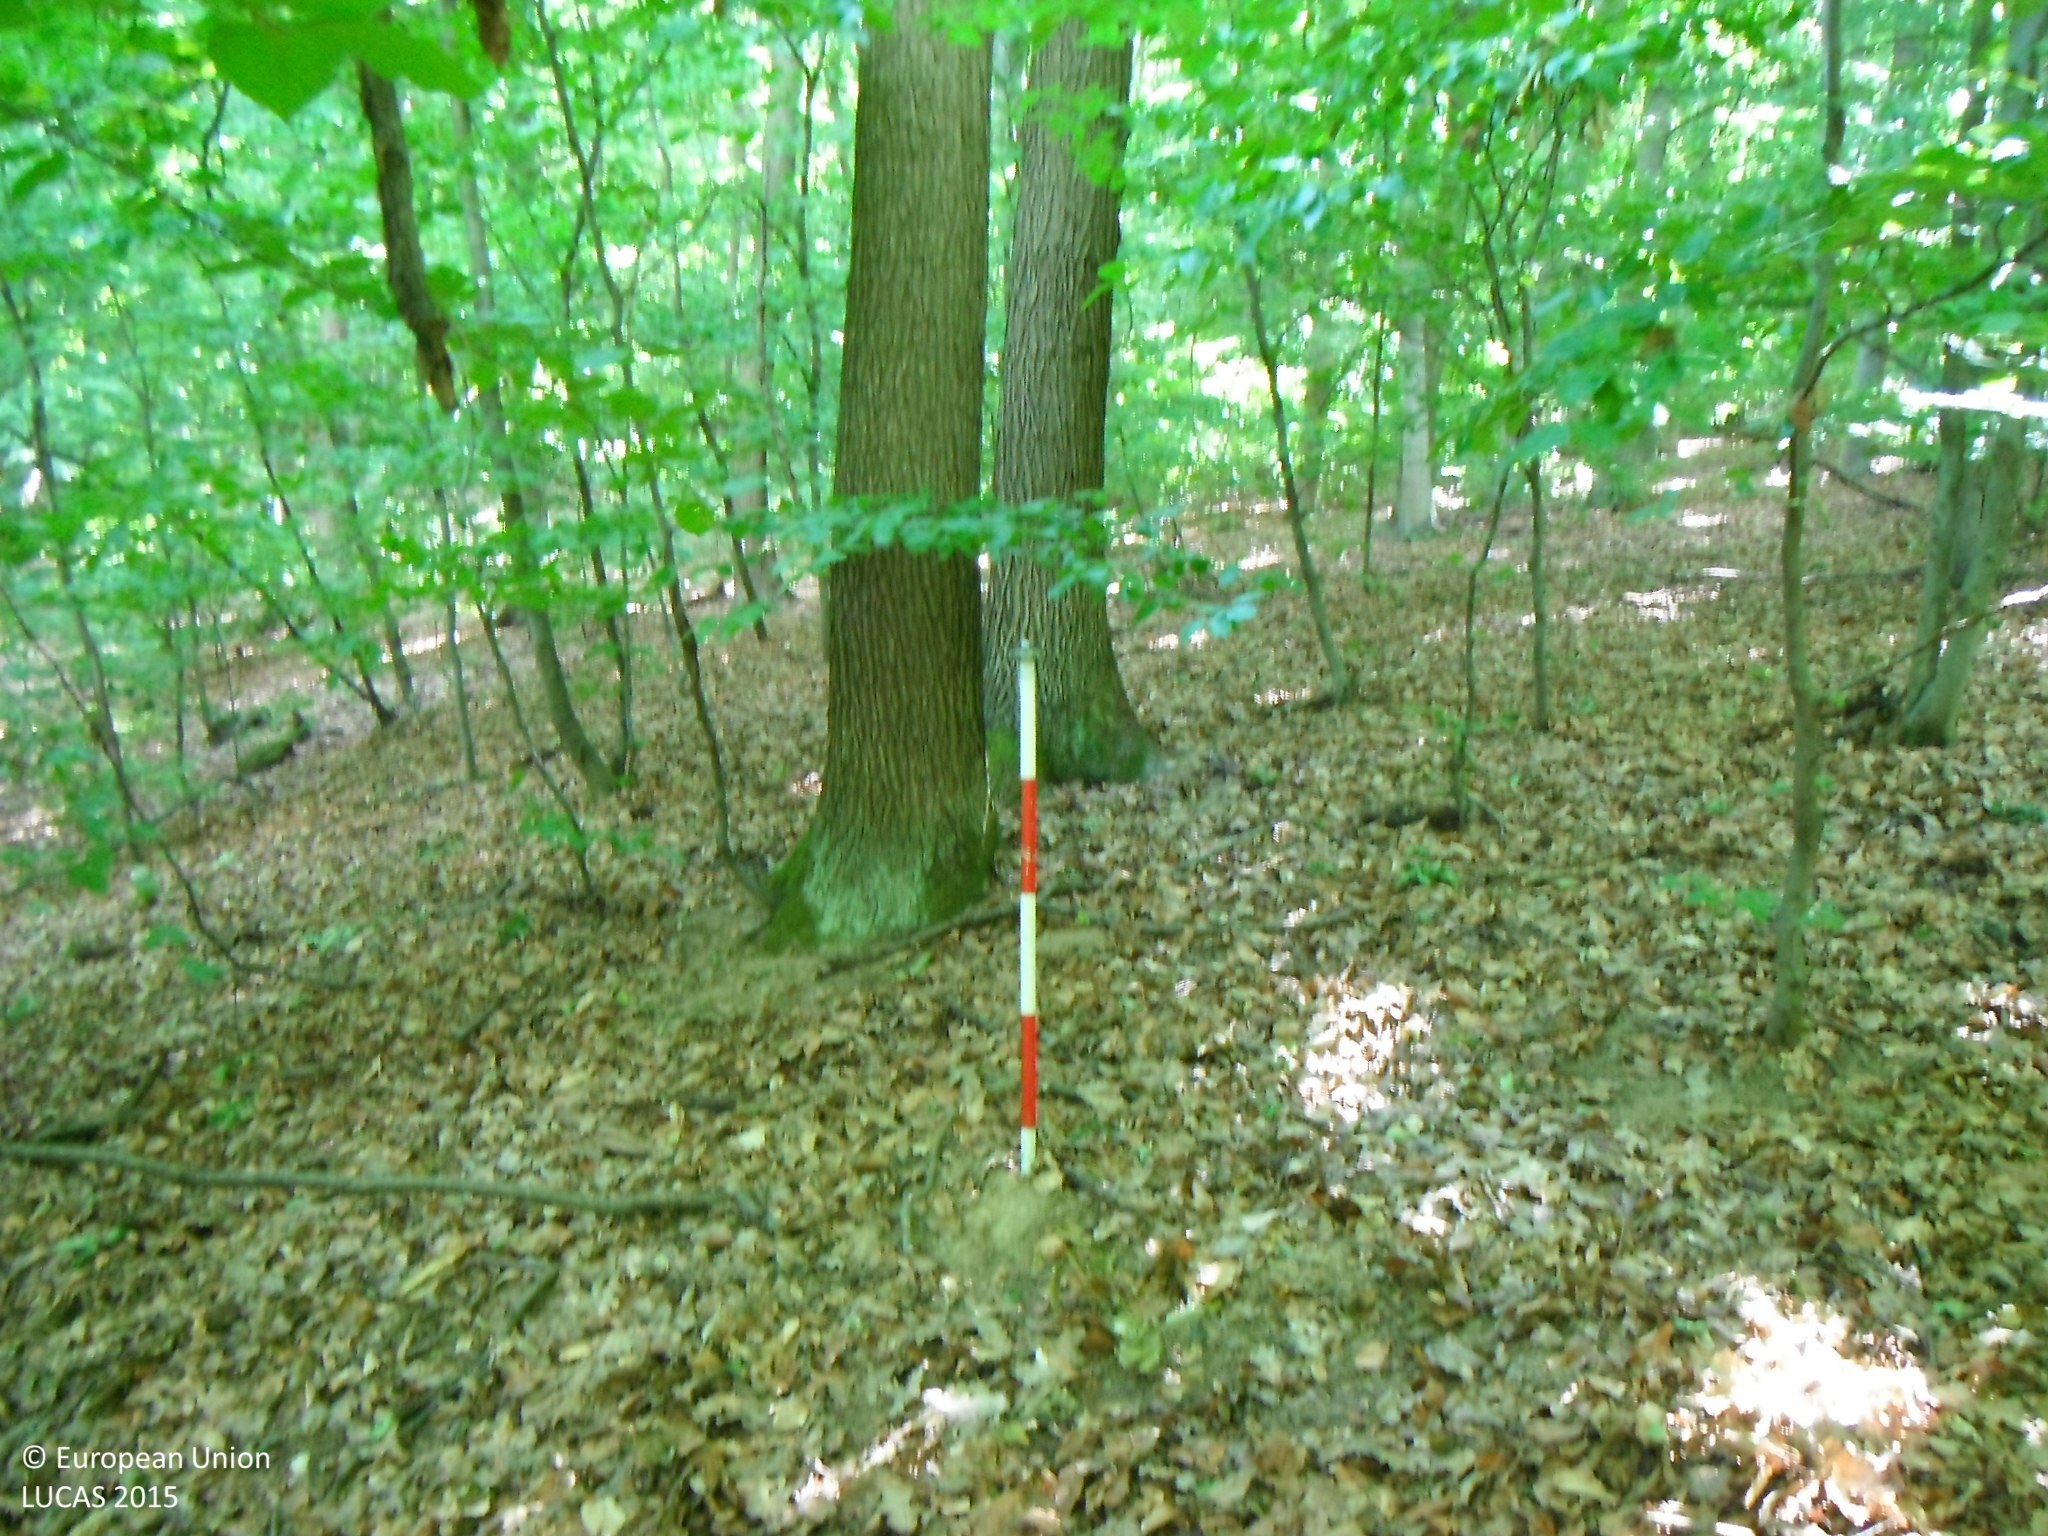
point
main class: Woodland
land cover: Broadleaved woodland
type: mesophytic deciduous forest
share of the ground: > 75 %
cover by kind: broadleaved forest trees 100 %
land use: Forestry
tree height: > 5 m
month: July
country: SK
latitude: 48.2887
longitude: 19.8528
